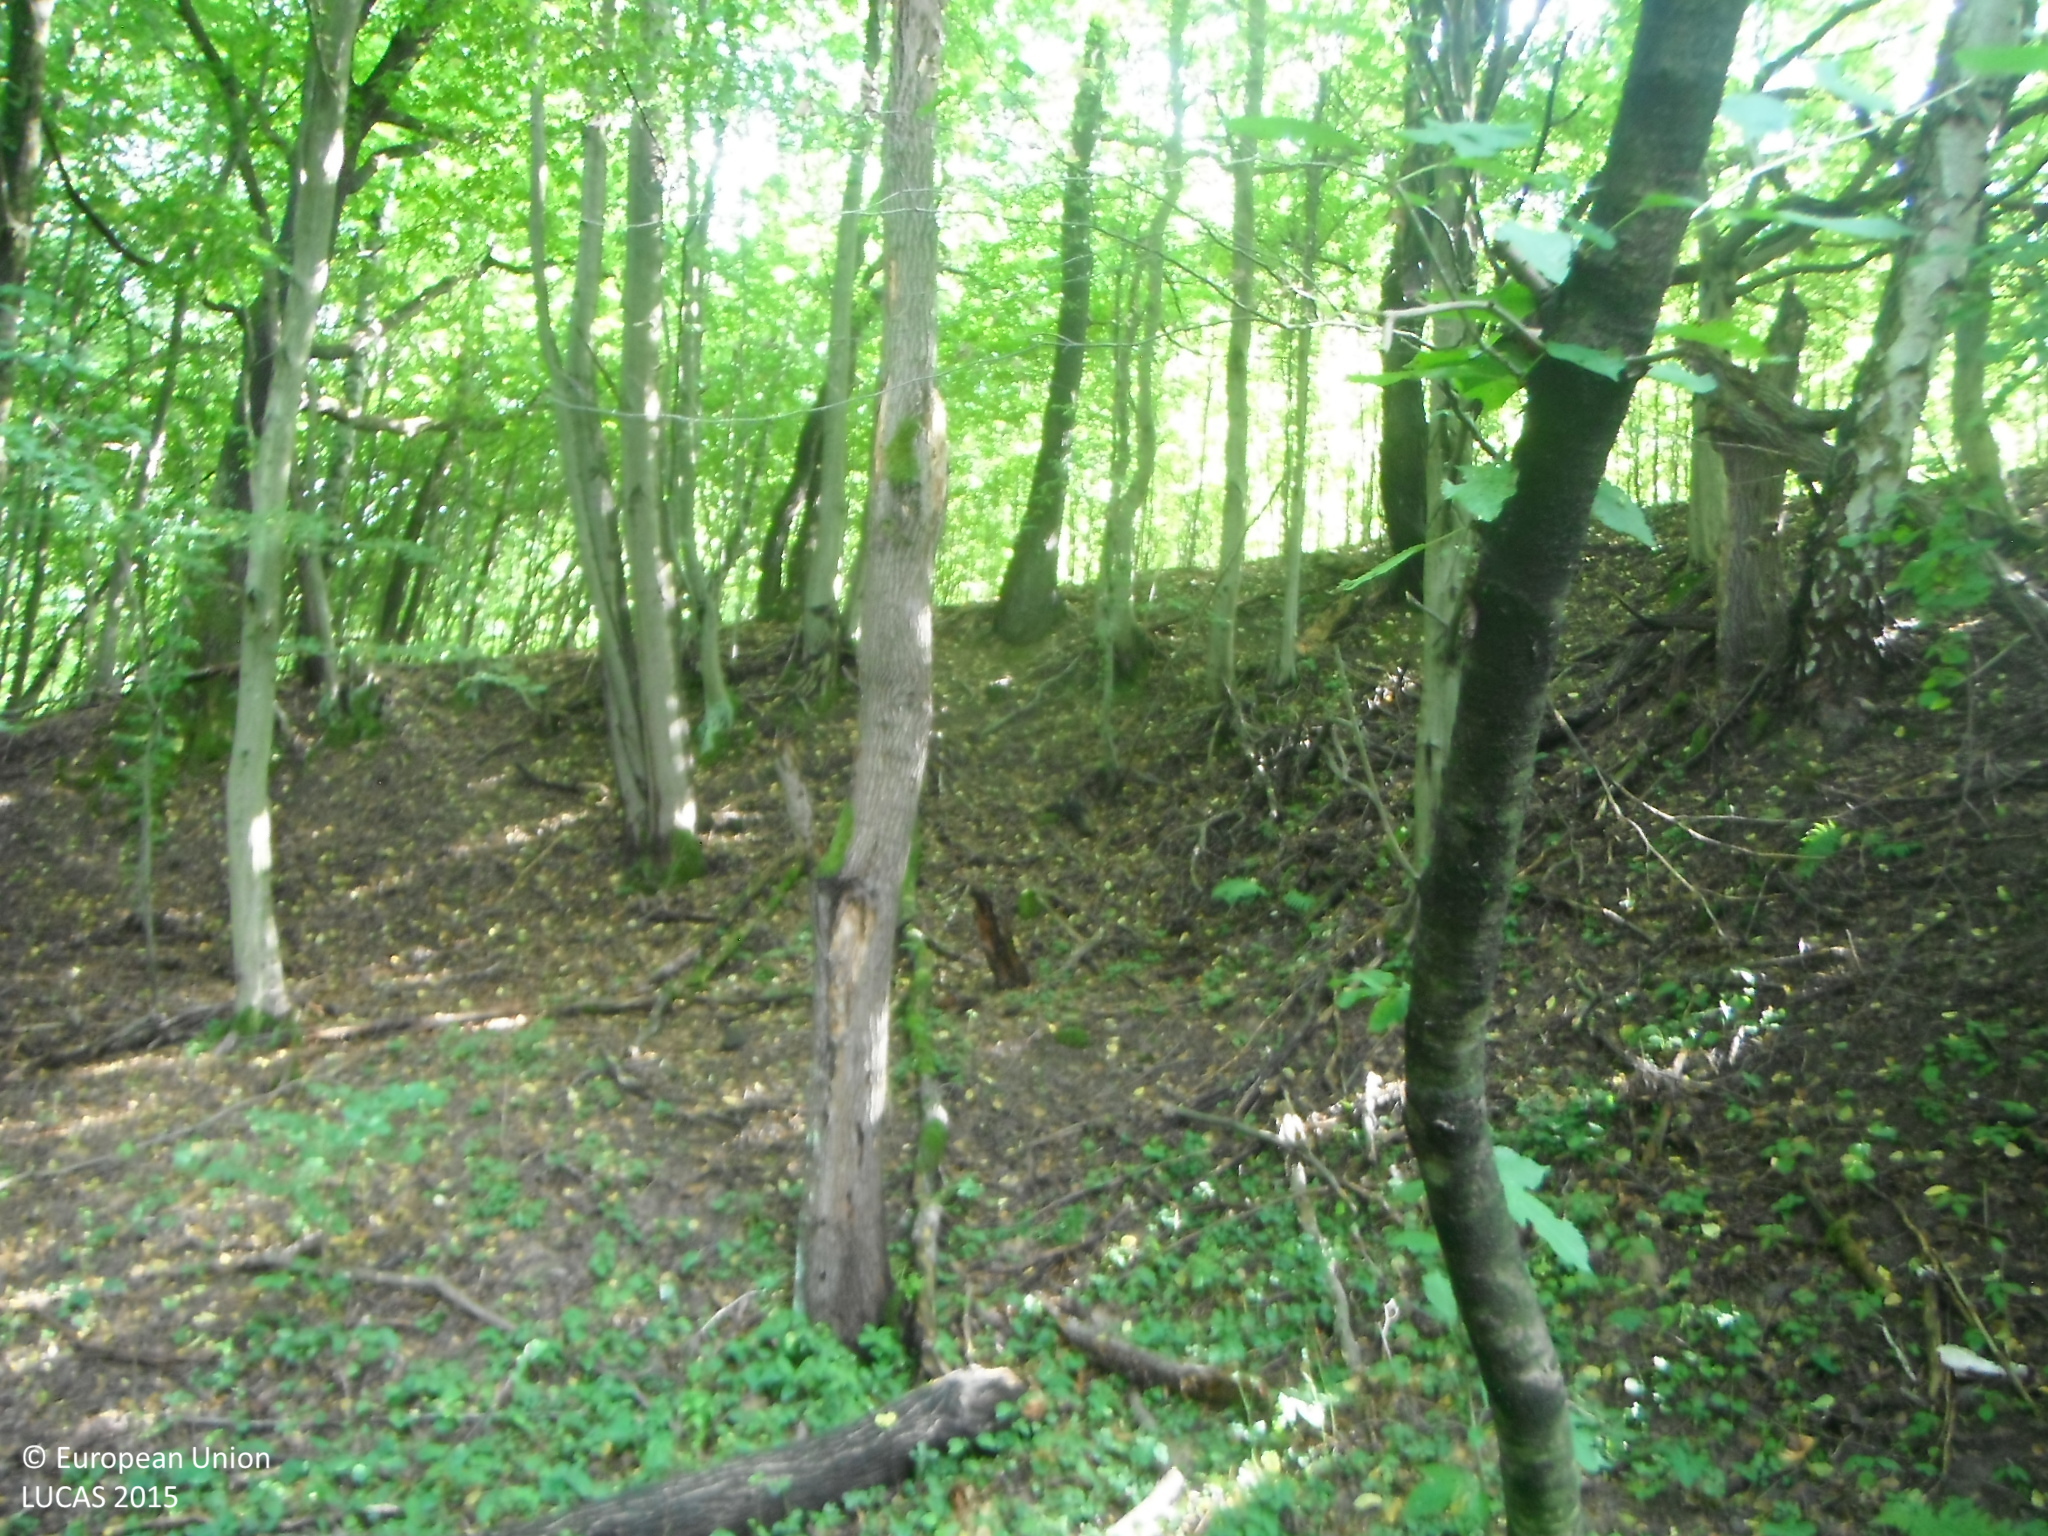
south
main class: Woodland
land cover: Broadleaved woodland
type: mesophytic deciduous forest
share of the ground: > 75 %
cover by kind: broadleaved forest trees 100 %
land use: Forestry
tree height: > 5 m
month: August
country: SK
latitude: 48.7918
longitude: 18.3607
